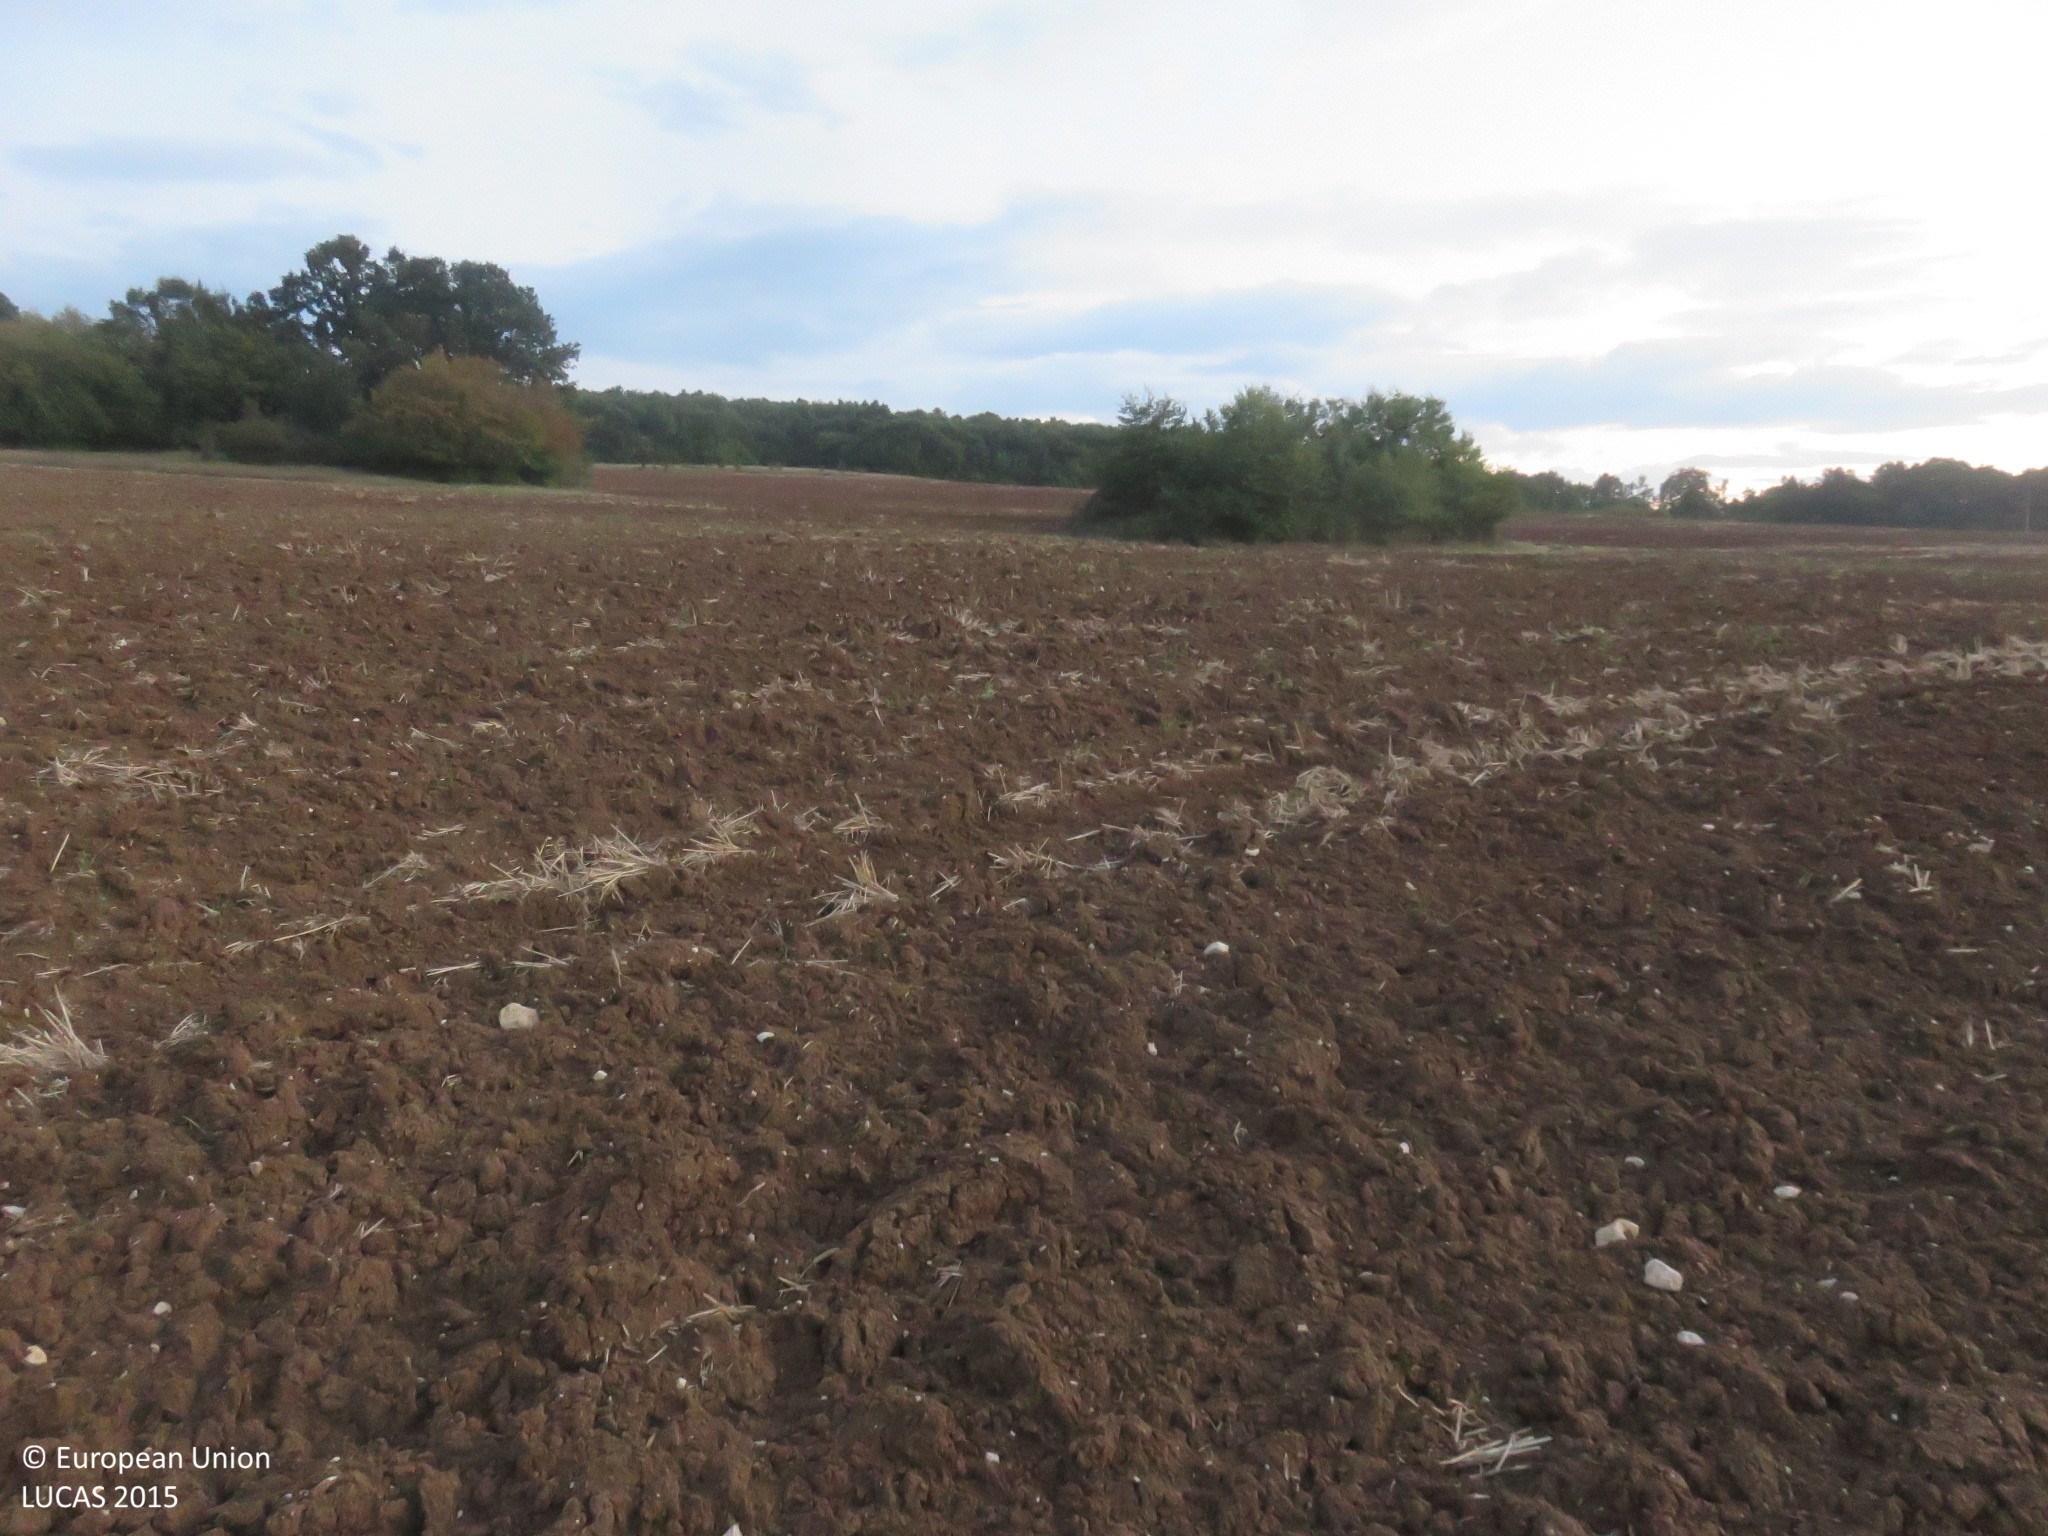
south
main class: Cropland
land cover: Common wheat
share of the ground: < 10 %
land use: Agriculture (excluding fallow land and kitchen gardens)
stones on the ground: < 10 %
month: September
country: BG
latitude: 43.0679
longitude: 25.0119
